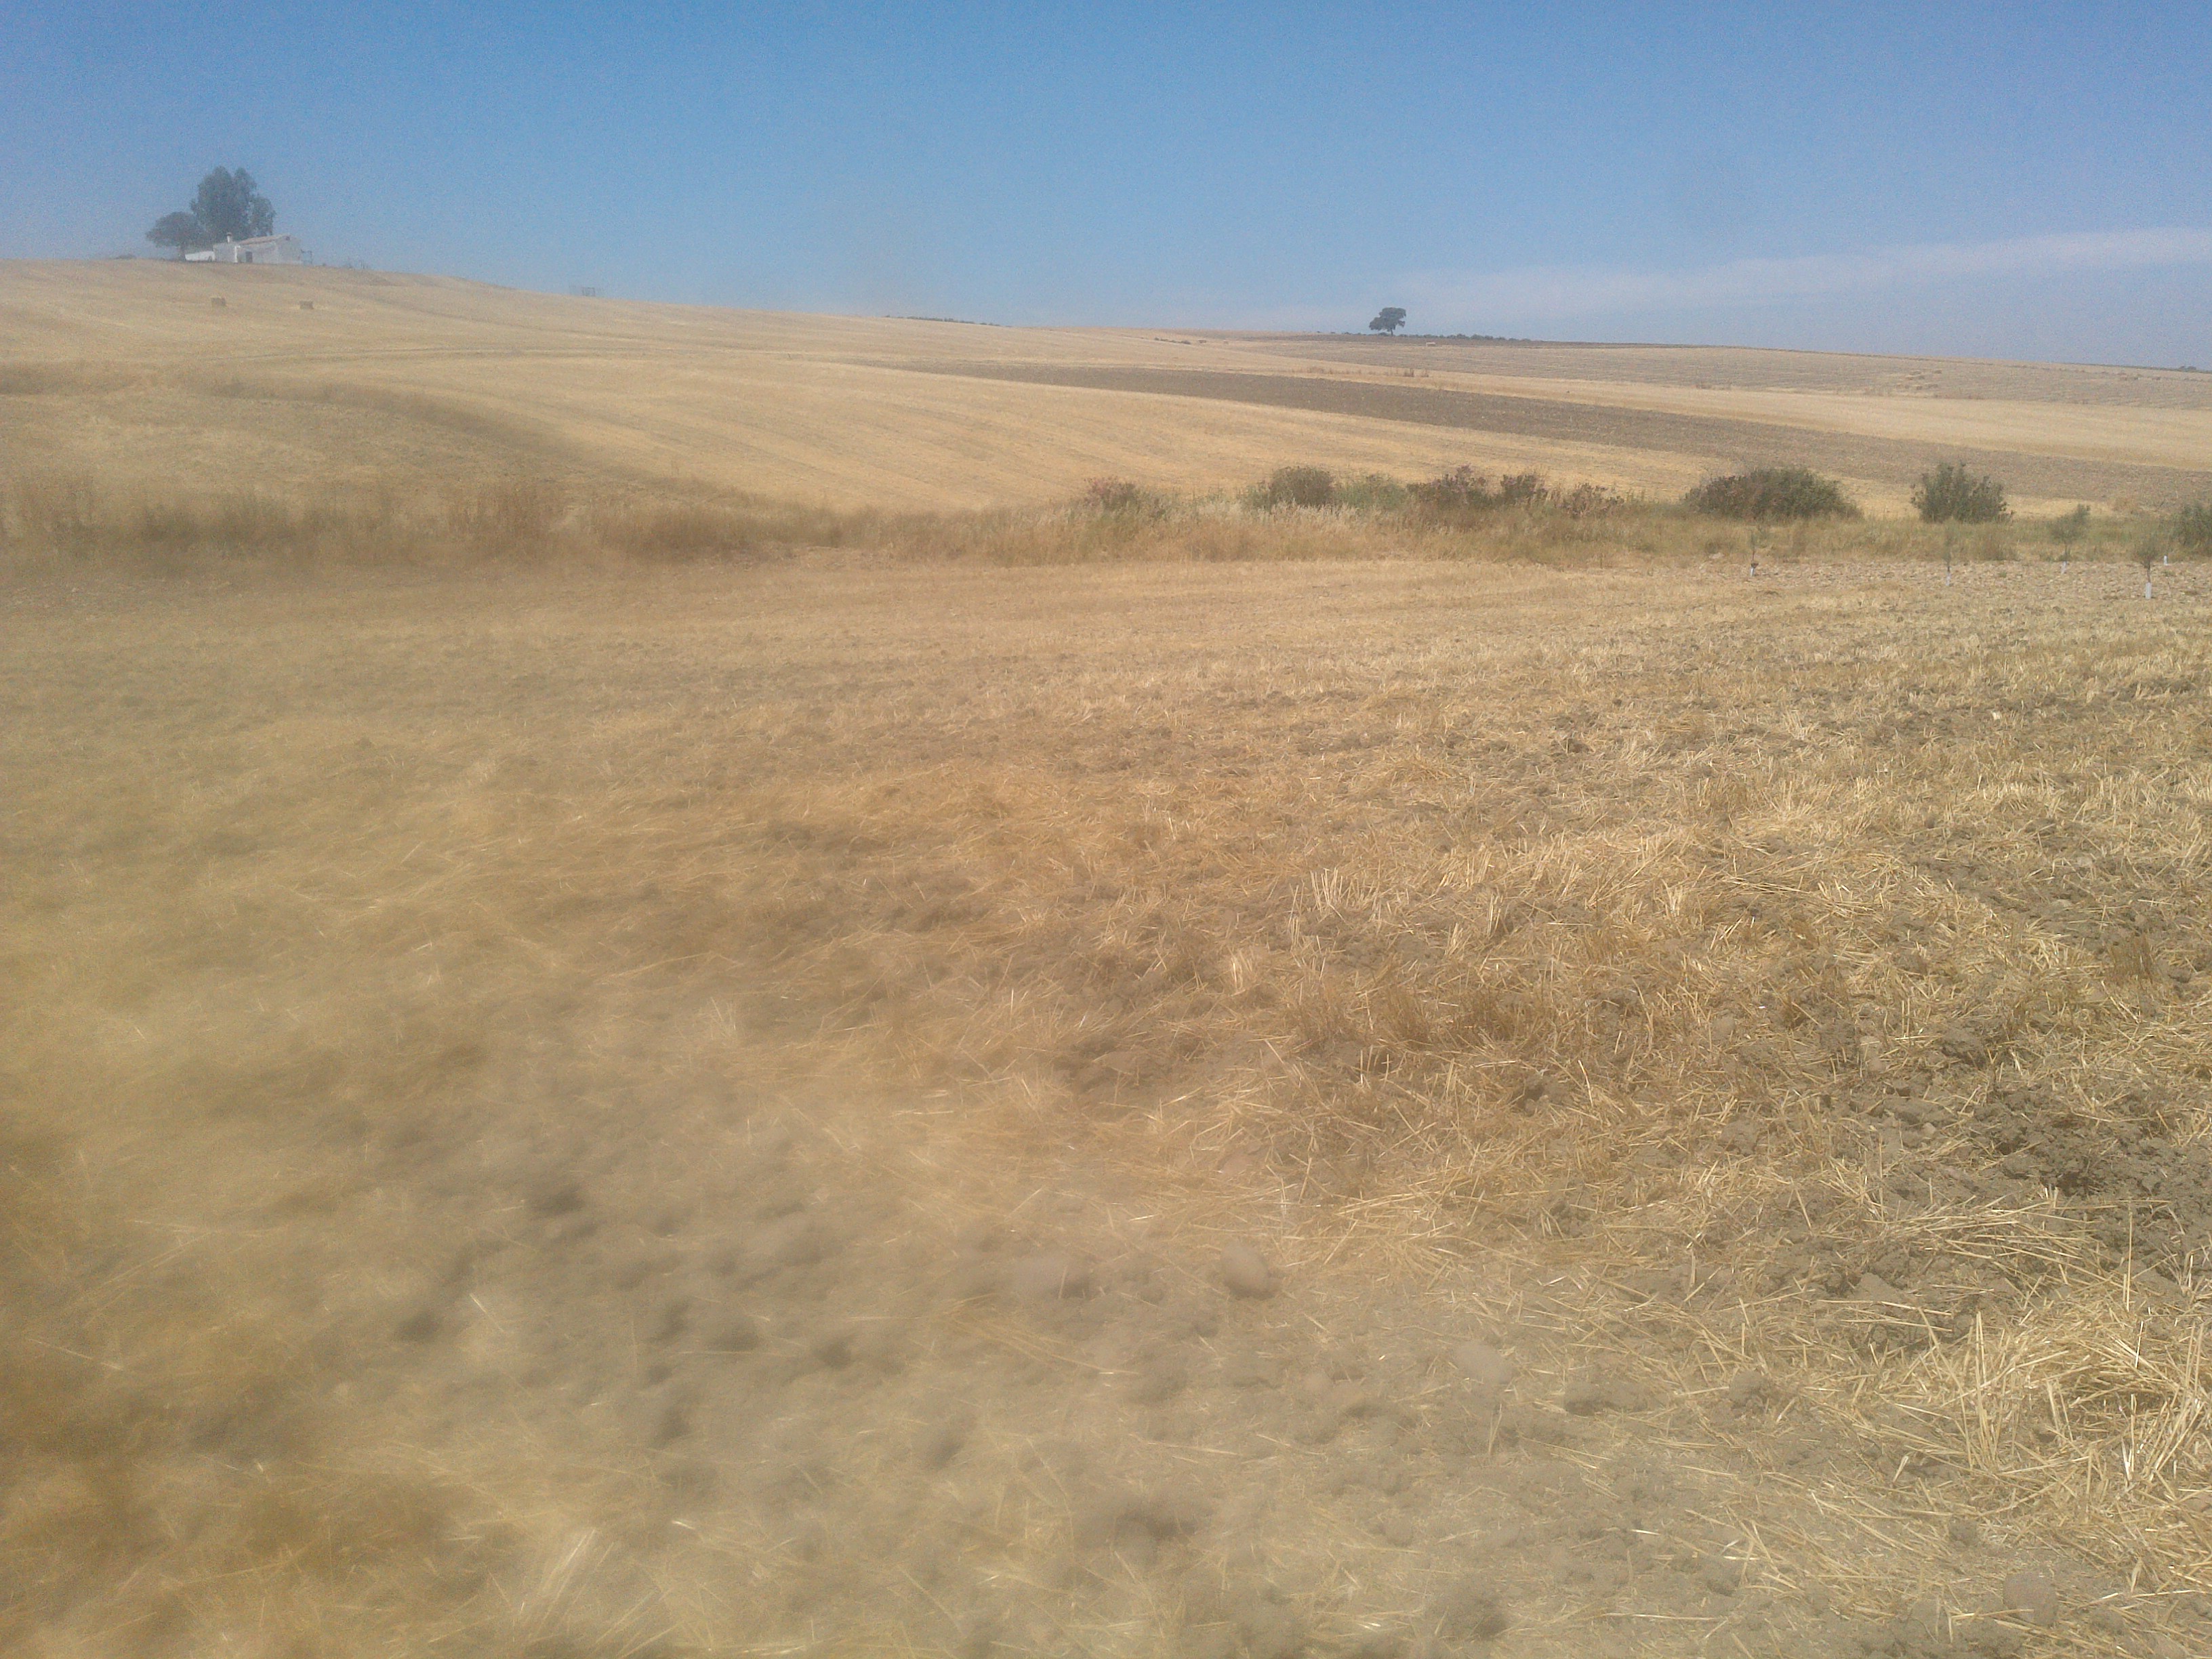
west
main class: Cropland
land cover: Durum wheat
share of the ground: < 10 %
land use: Agriculture (excluding fallow land and kitchen gardens)
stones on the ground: 10 - 25 %
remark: Harvested field
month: June
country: ES
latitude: 37.6708
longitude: -4.8984
